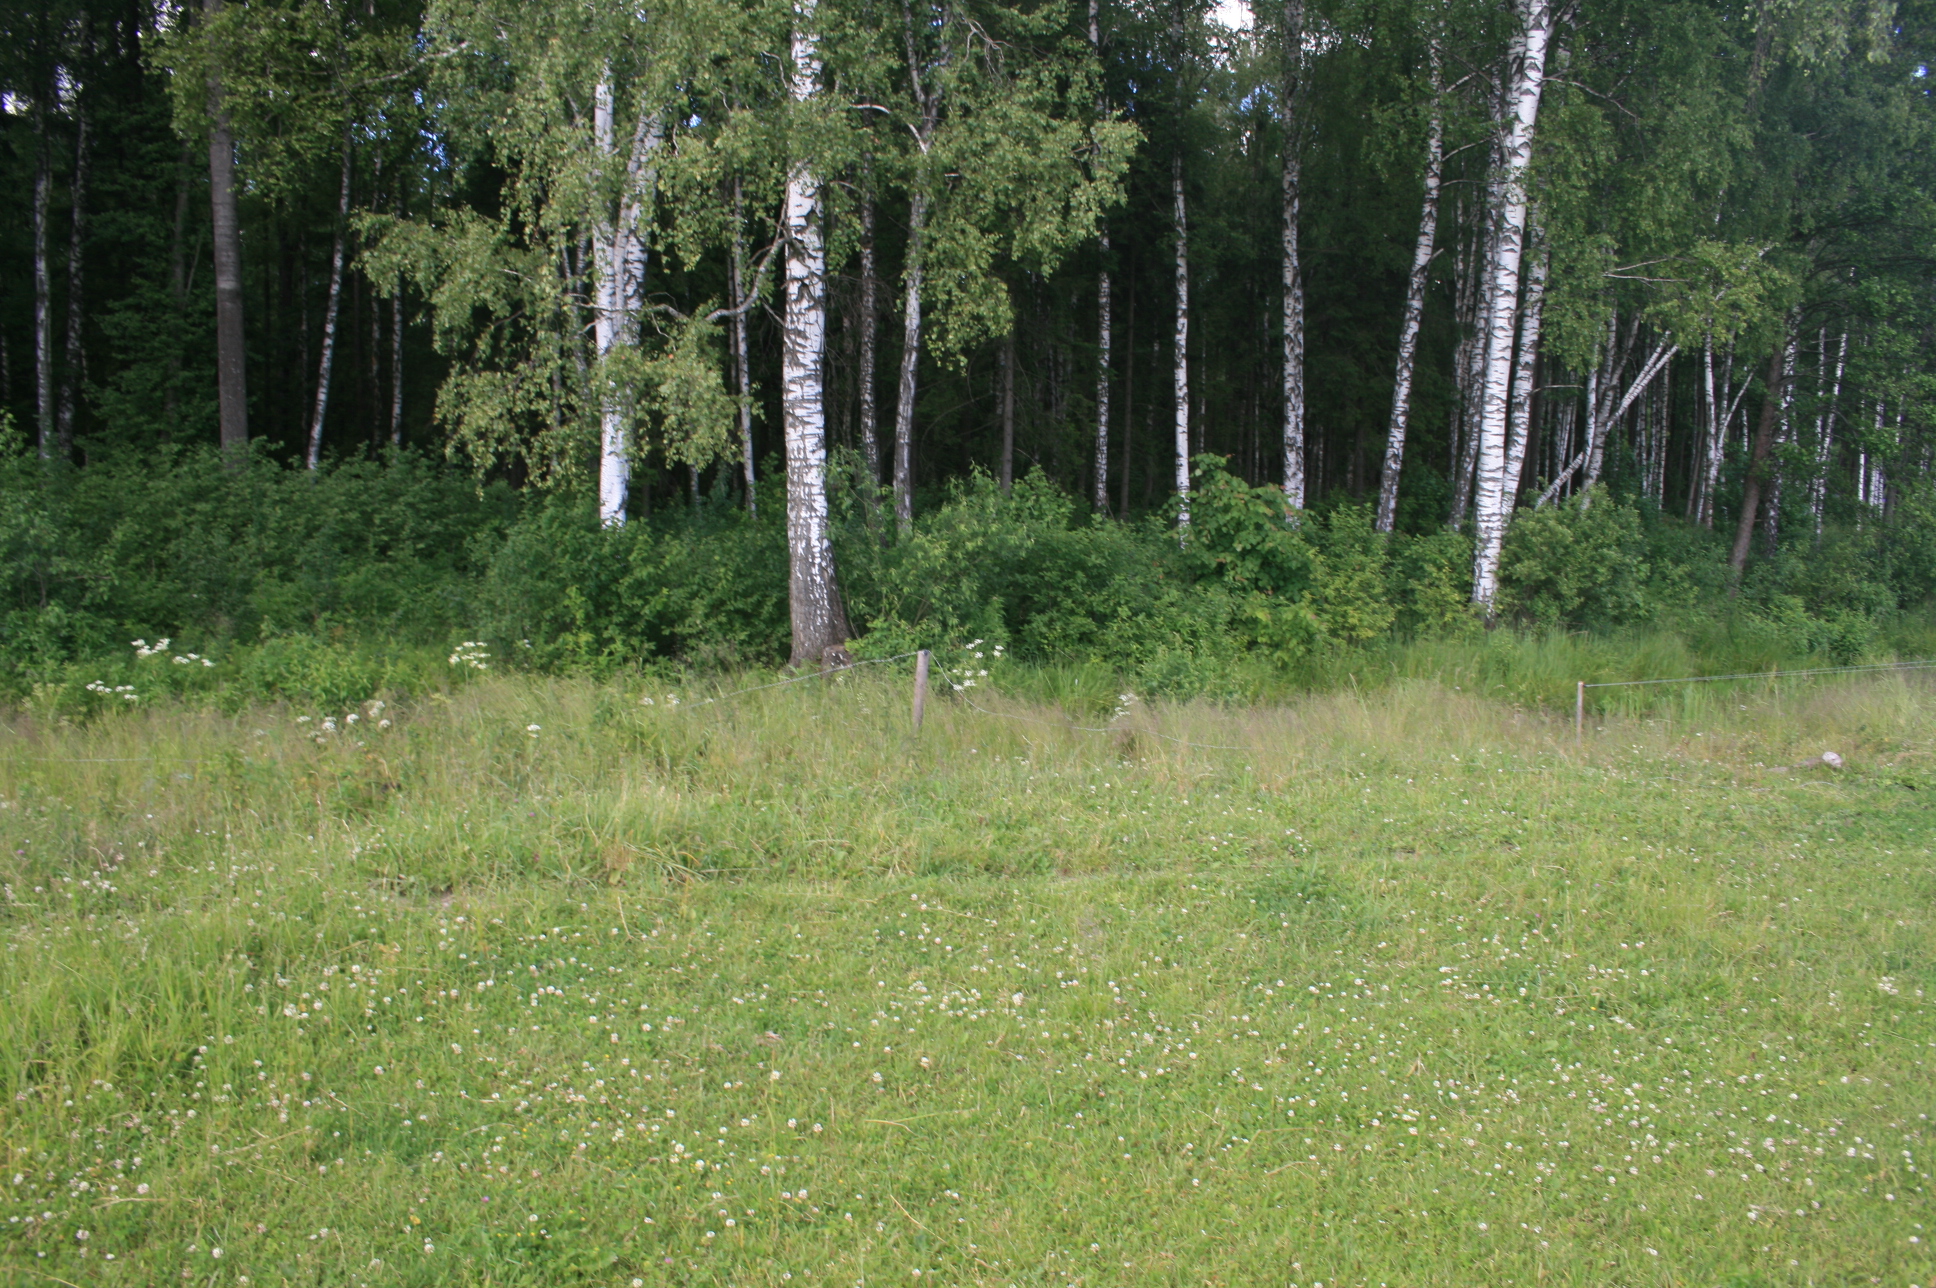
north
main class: Grassland
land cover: Grassland without tree/shrub cover
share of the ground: > 75 %
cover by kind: herbaceous plants 100 %
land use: Agriculture (excluding fallow land and kitchen gardens)
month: June
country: LT
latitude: 55.4234
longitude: 22.1746
